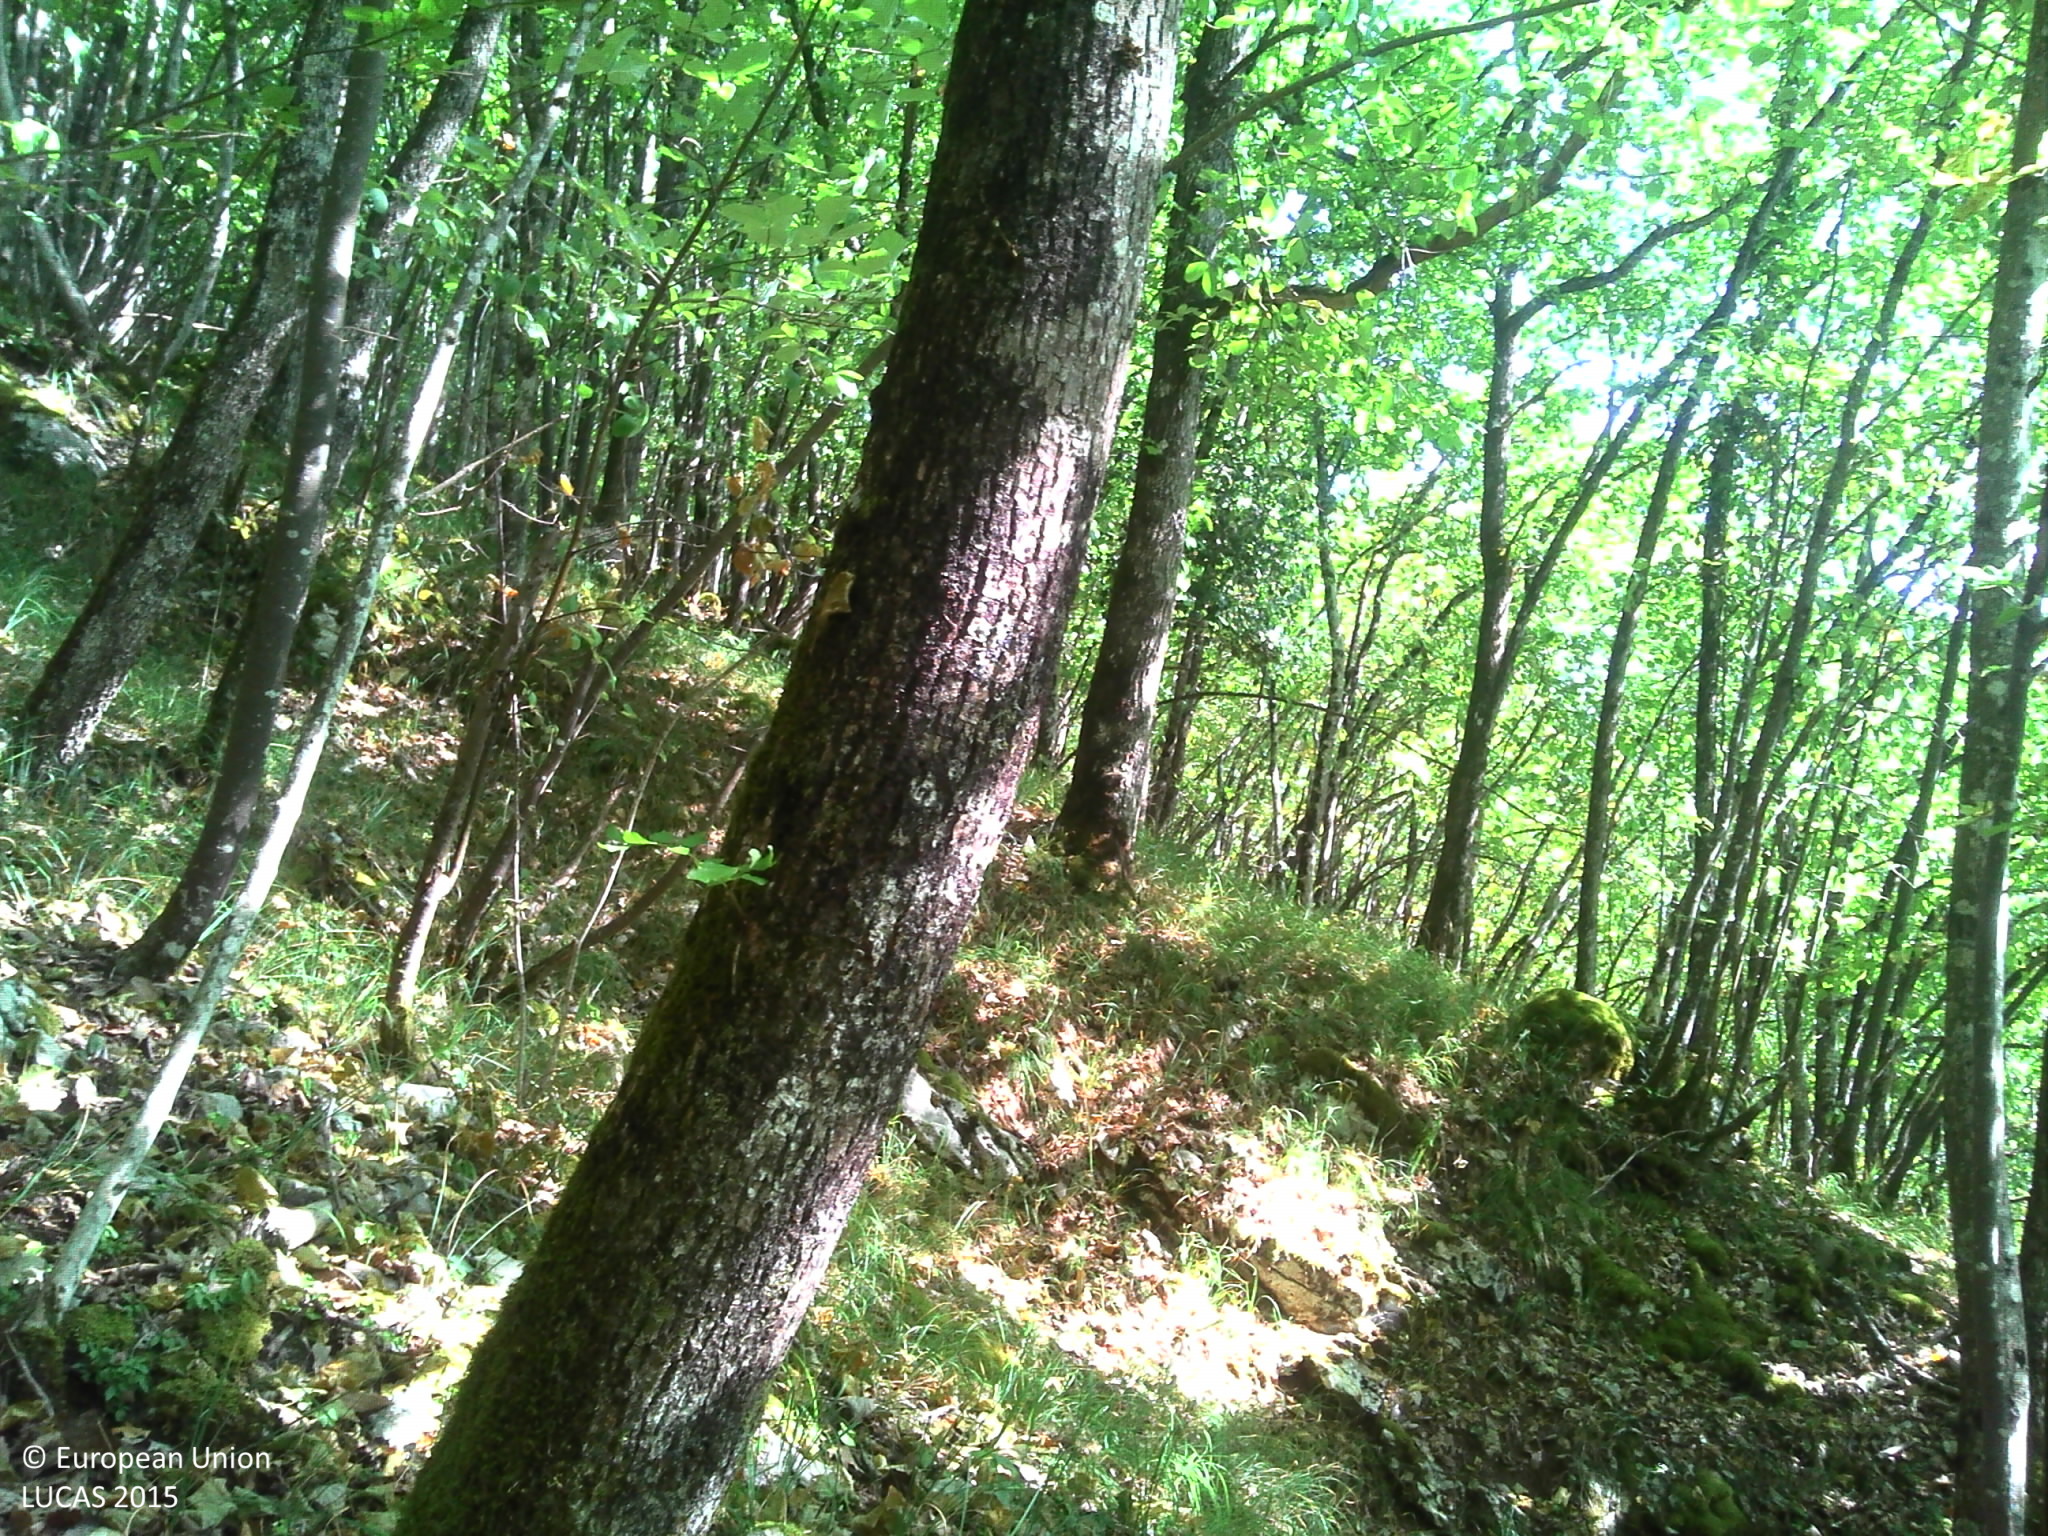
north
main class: Woodland
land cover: Broadleaved woodland
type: beech forest
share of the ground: > 75 %
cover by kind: broadleaved forest trees 90 %, herbaceous plants 5 %, unconsolidated bare surface 5 %
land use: Forestry
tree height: > 5 m
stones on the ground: 10 - 25 %
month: July
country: FR
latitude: 45.8303
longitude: 6.1293
